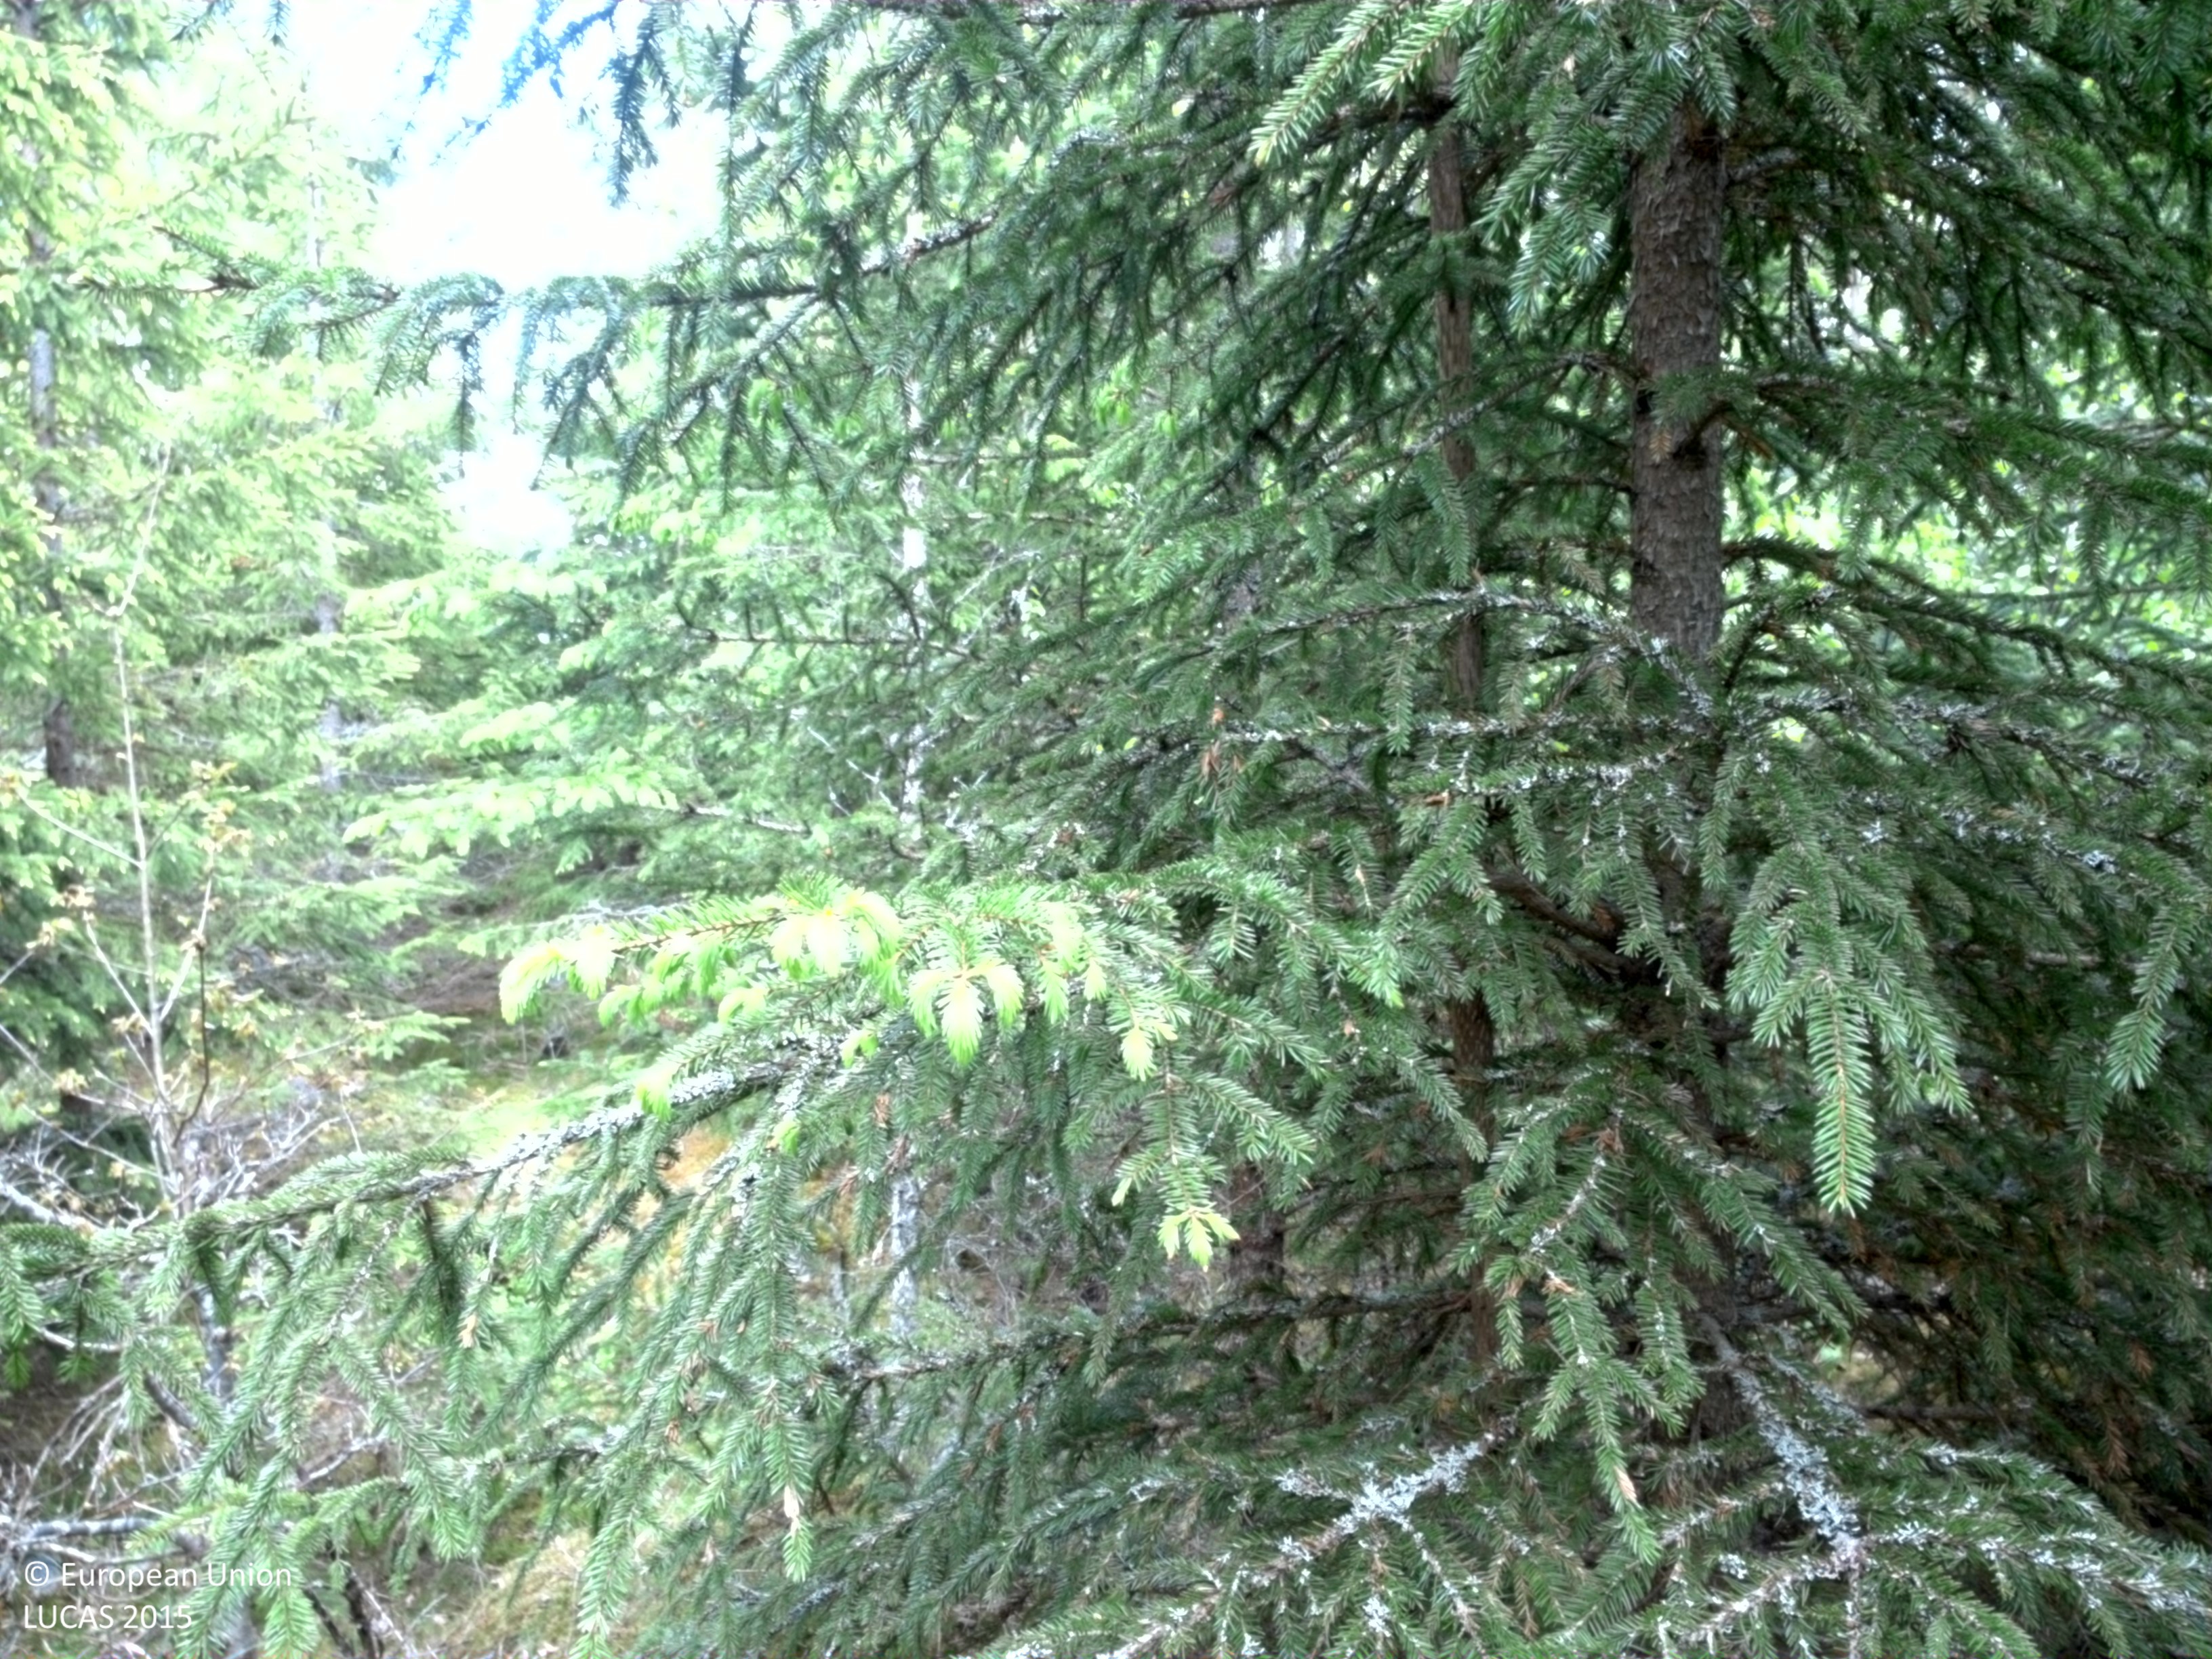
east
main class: Woodland
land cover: Spruce dominated coniferous woodland
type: boreal forest
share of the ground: 50 - 75 %
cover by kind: coniferous forest trees 60 %, broadleaved forest trees 10 %, shrubs 10 %, herbaceous plants 10 %, lichens and mosses 10 %
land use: Forestry
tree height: > 5 m
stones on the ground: > 50 %
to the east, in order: Spruce dominated coniferous woodland; Spruce dominated mixed woodland
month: May
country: SE
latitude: 57.2565
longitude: 15.9827
